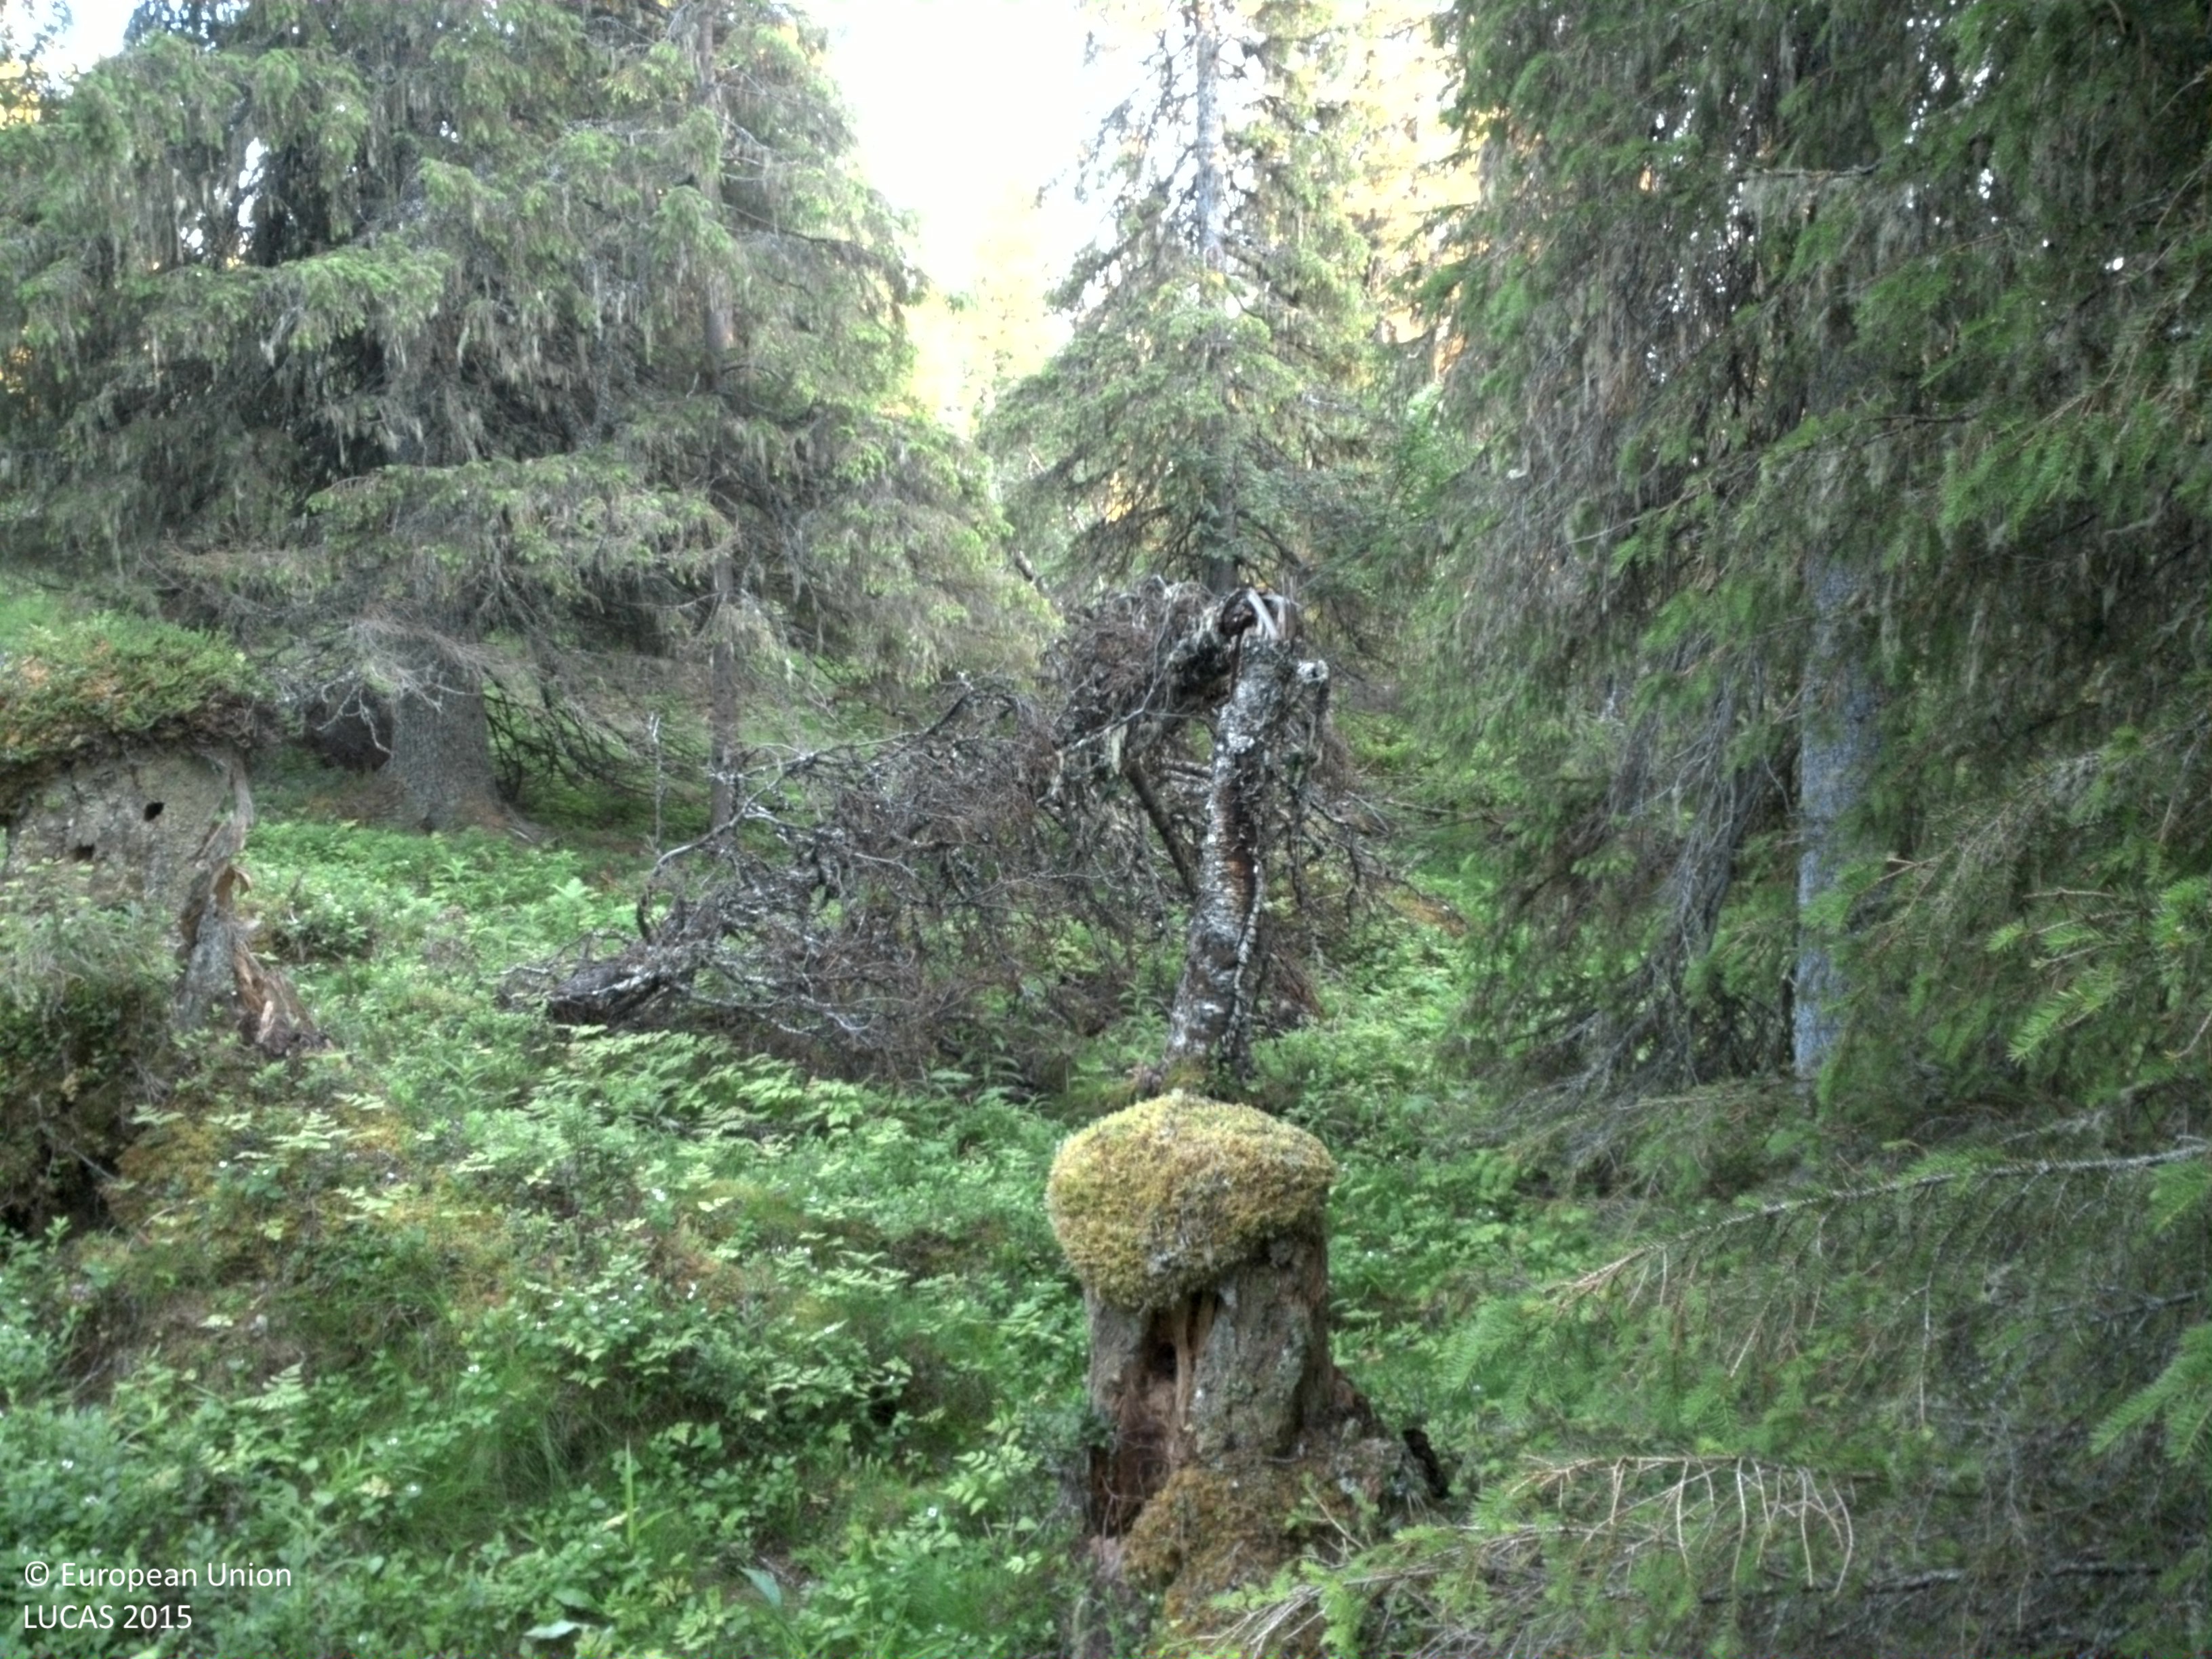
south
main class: Woodland
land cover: Spruce dominated coniferous woodland
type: boreal forest
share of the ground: 25 - 50 %
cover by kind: coniferous forest trees 40 %, herbaceous plants 30 %, shrubs 25 %, lichens and mosses 5 %
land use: Forestry
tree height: > 5 m
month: August
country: SE
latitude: 64.9746
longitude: 15.9619
